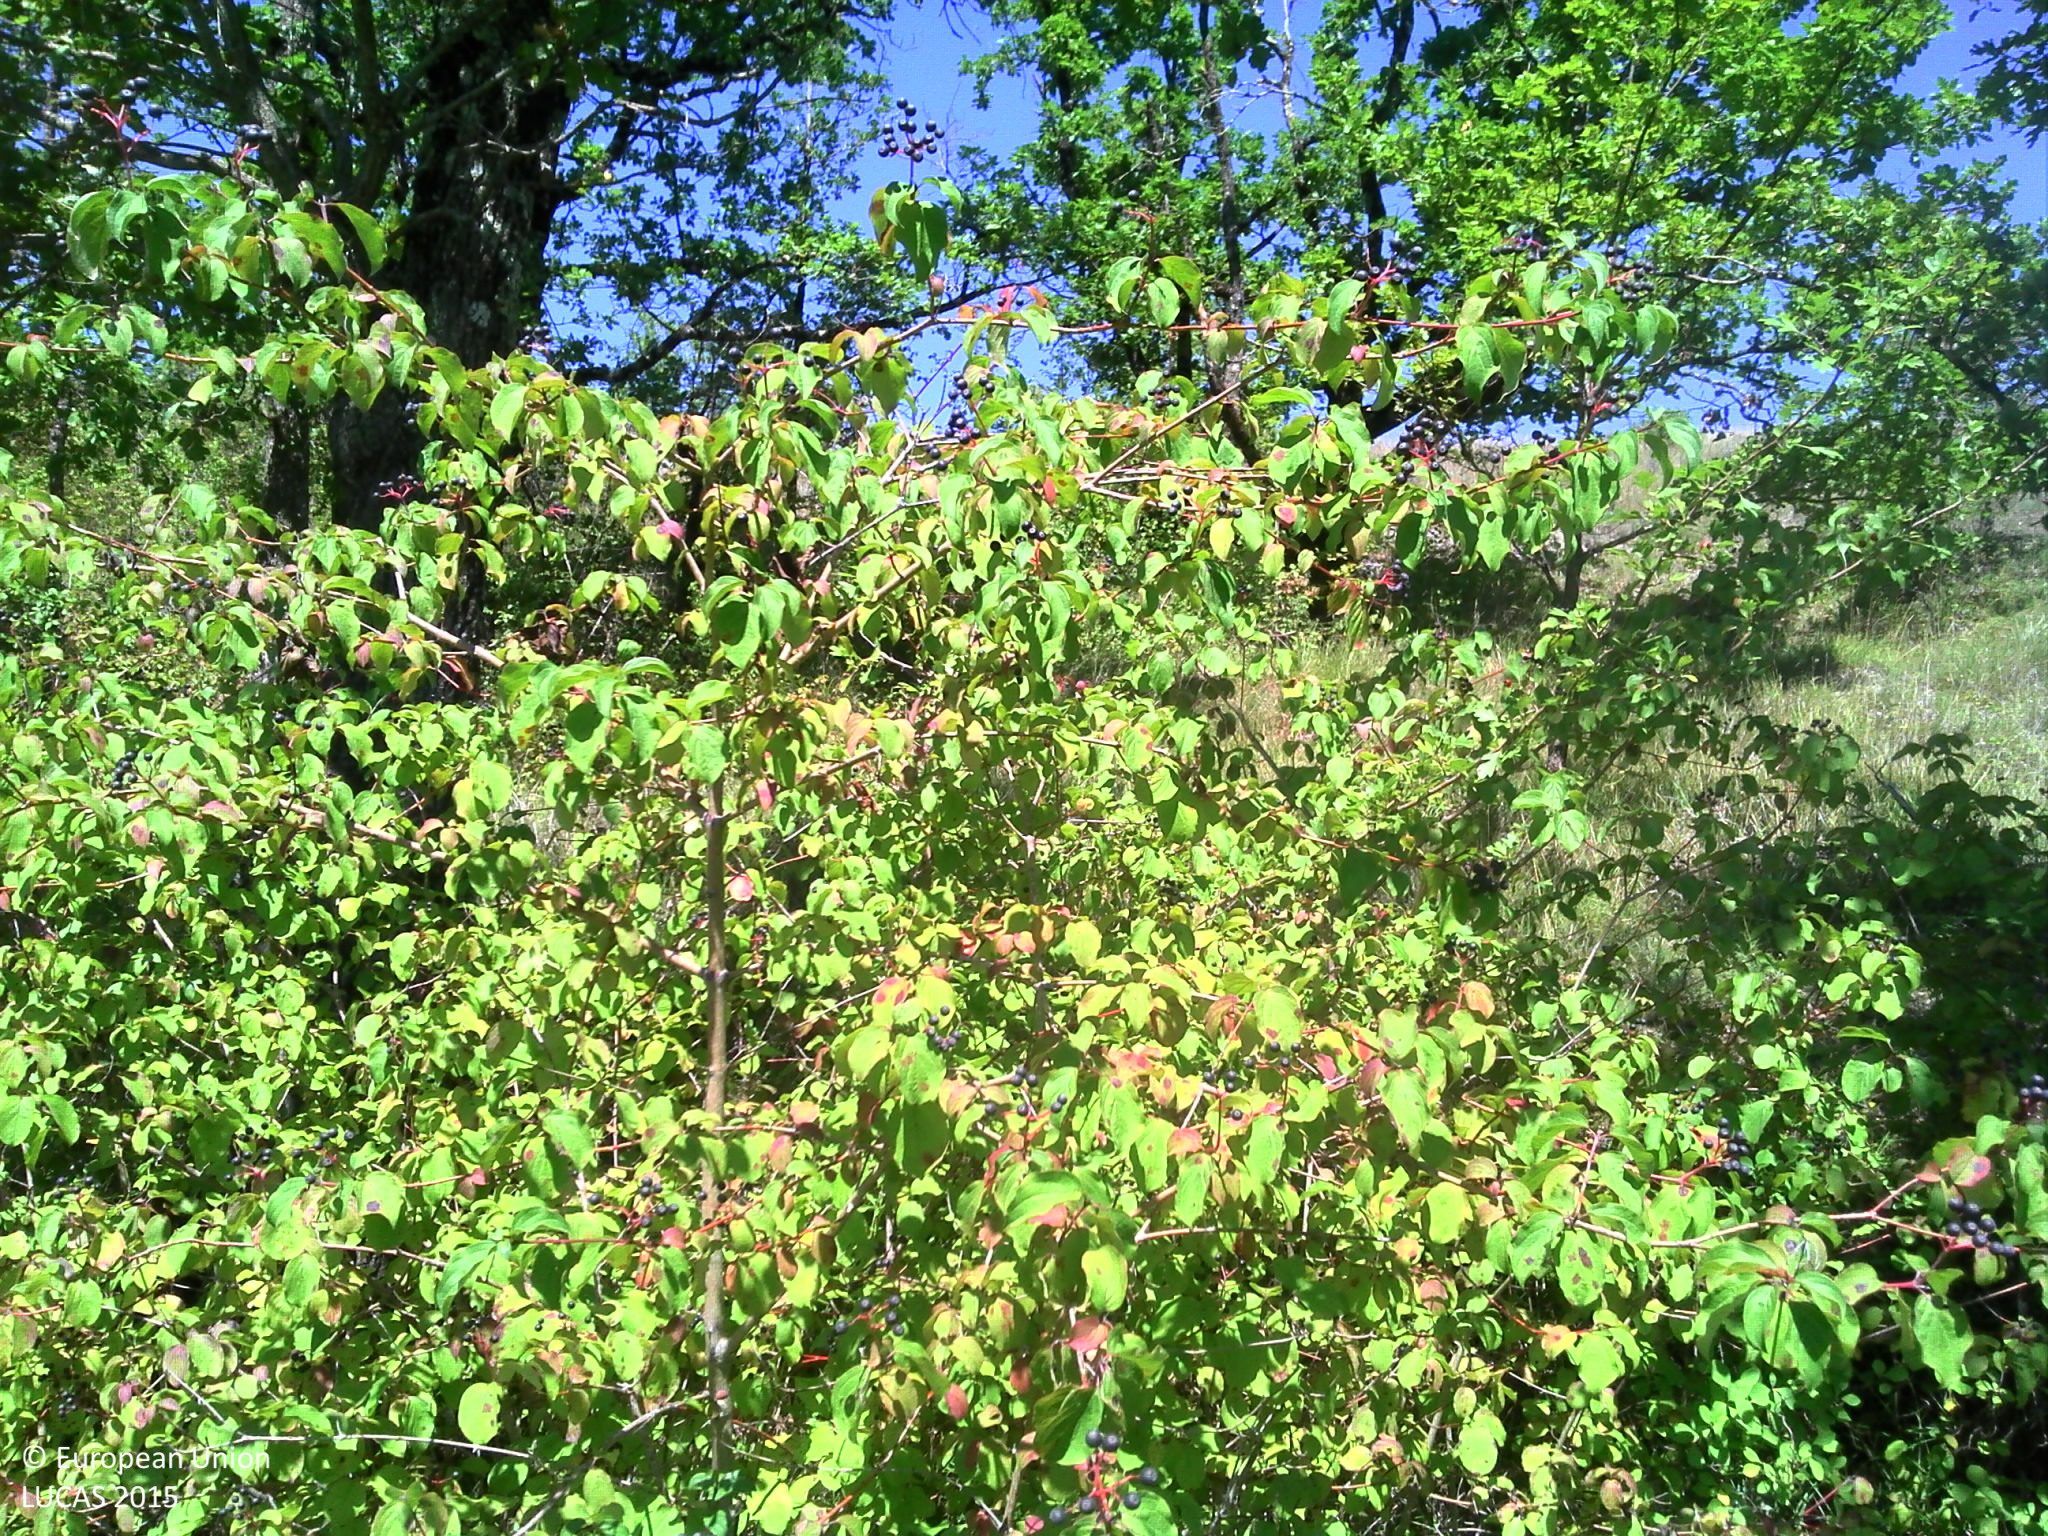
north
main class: Grassland
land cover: Grassland without tree/shrub cover
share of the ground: > 75 %
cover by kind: herbaceous plants 100 %
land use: Agriculture (excluding fallow land and kitchen gardens)
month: August
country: FR
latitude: 44.2767
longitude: 1.5423
